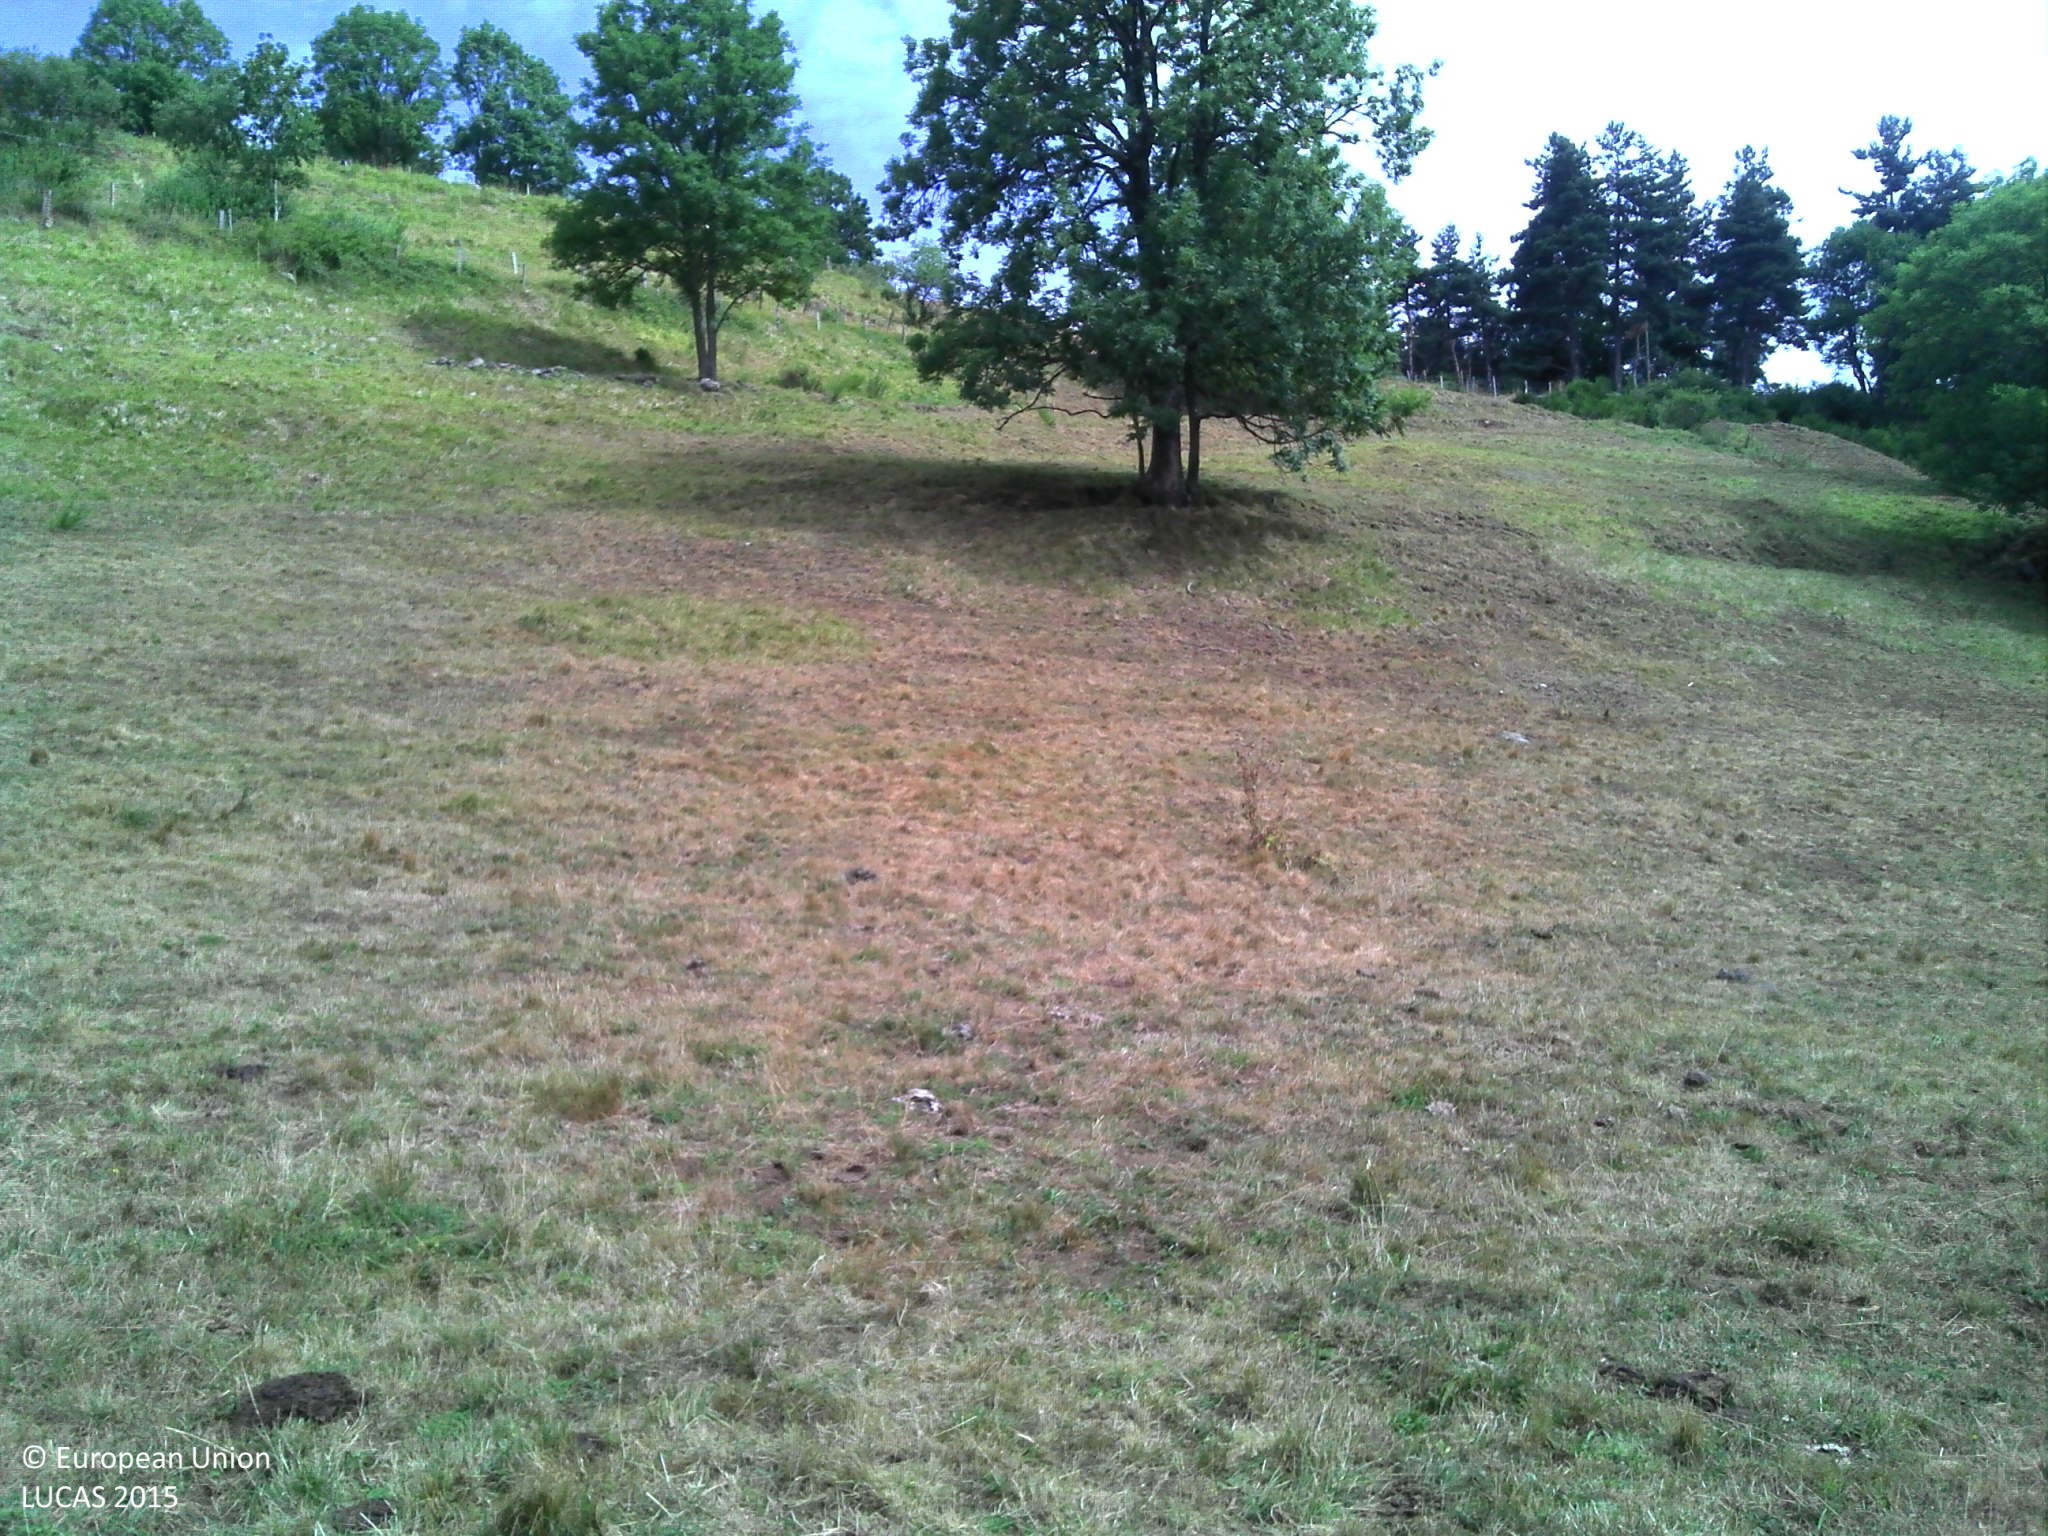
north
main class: Grassland
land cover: Grassland without tree/shrub cover
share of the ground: > 75 %
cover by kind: herbaceous plants 100 %
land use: Agriculture (excluding fallow land and kitchen gardens)
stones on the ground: < 10 %
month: July
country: FR
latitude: 44.7319
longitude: 3.9063
